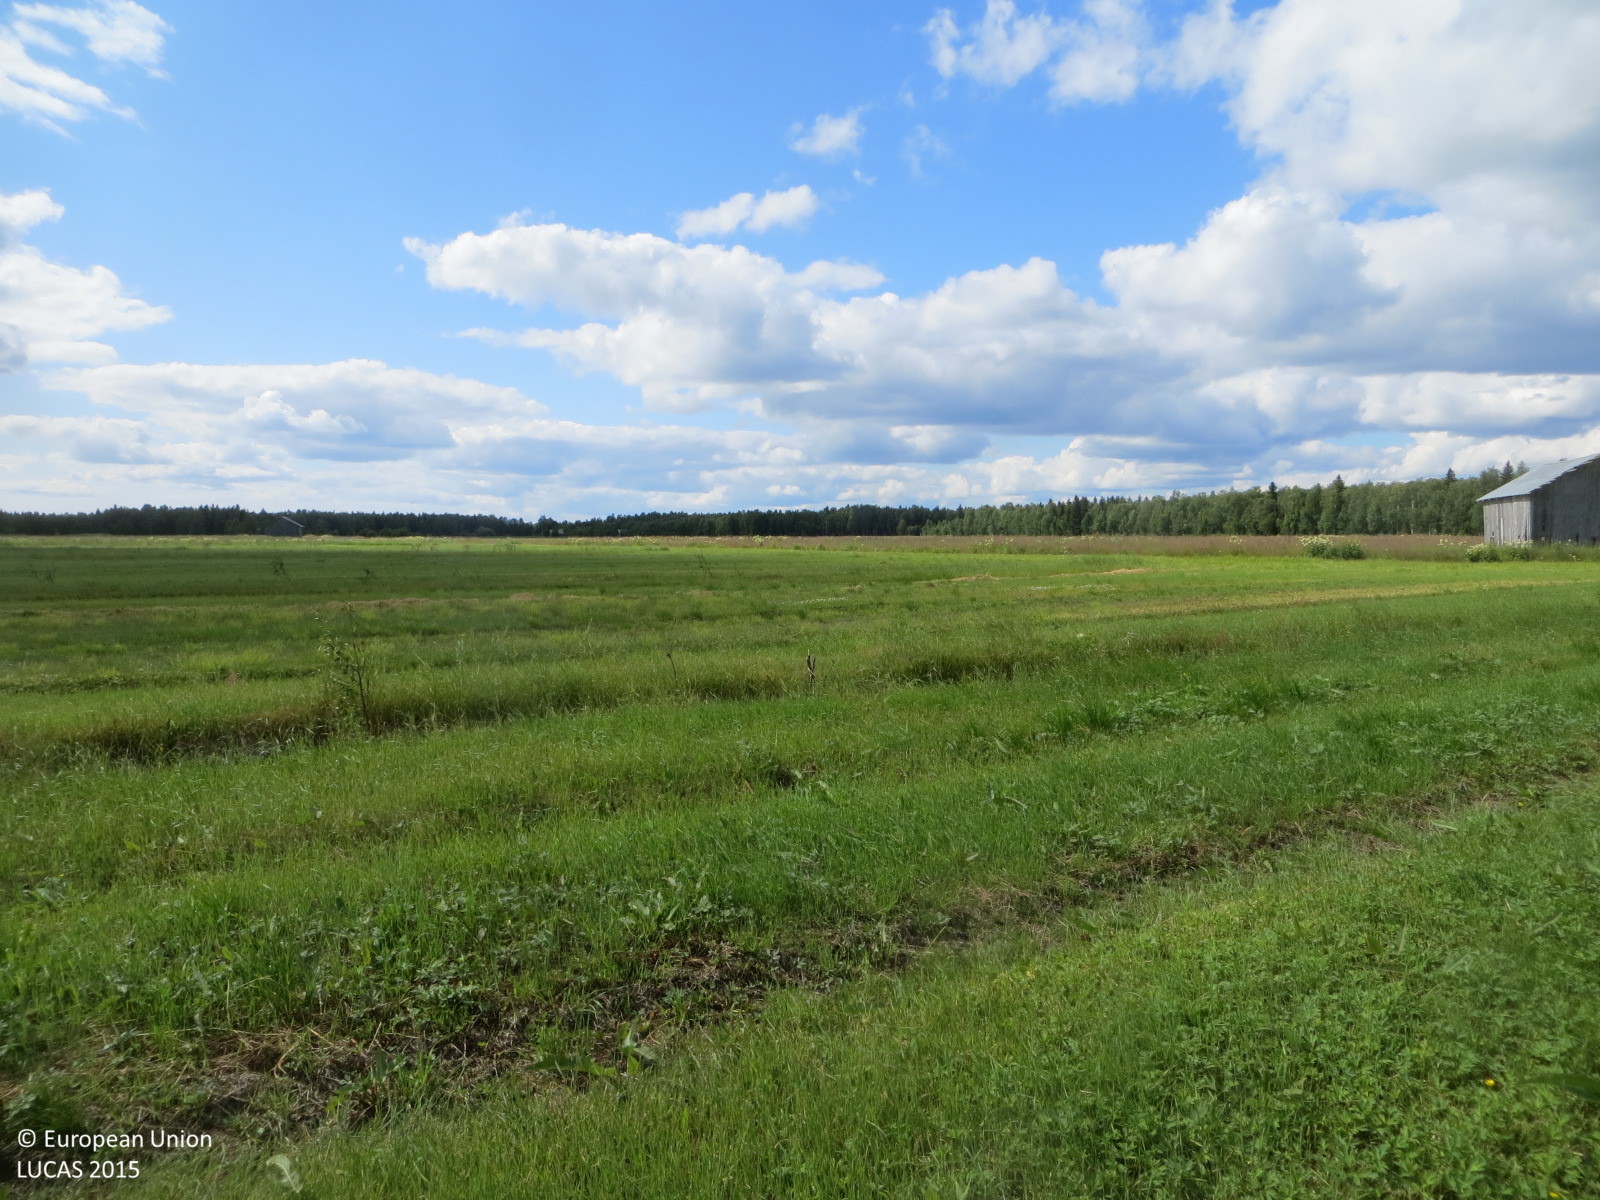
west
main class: Grassland
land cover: Spontaneously vegetated surfaces
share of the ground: > 75 %
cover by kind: herbaceous plants 100 %
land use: Fallow land
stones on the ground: < 10 %
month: July
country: FI
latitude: 65.8861
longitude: 24.2850
